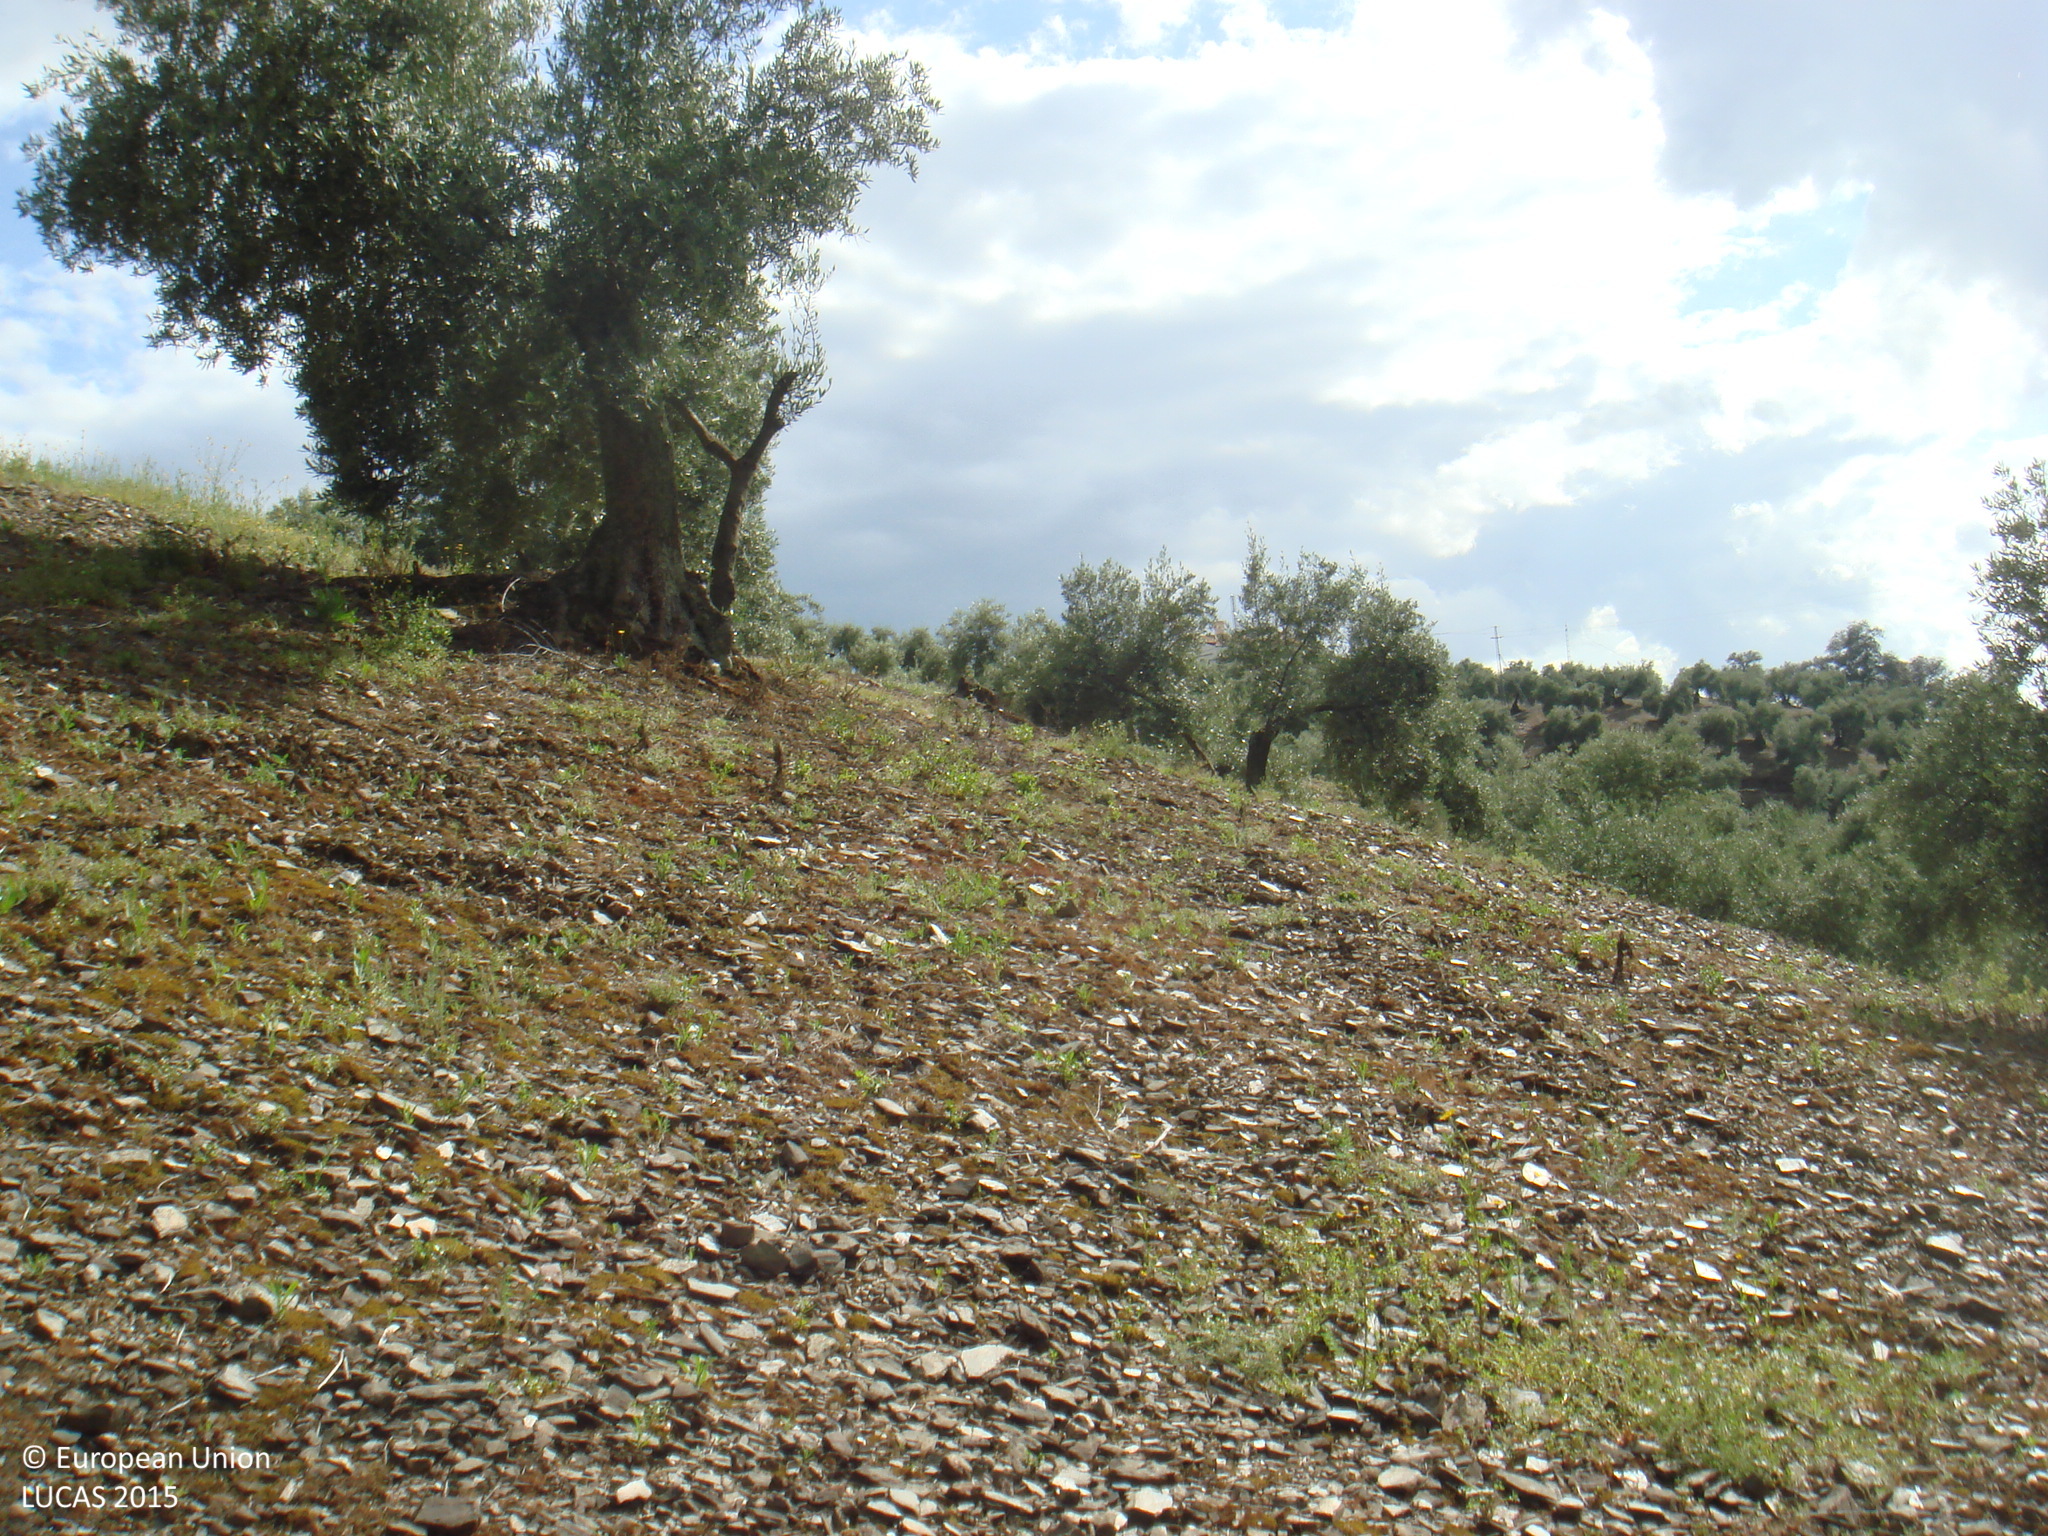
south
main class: Cropland
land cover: Olive groves
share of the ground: 50 - 75 %
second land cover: Other bare soil
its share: > 75 %
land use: Agriculture (excluding fallow land and kitchen gardens)
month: April
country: ES
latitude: 38.0909
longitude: -4.3214
